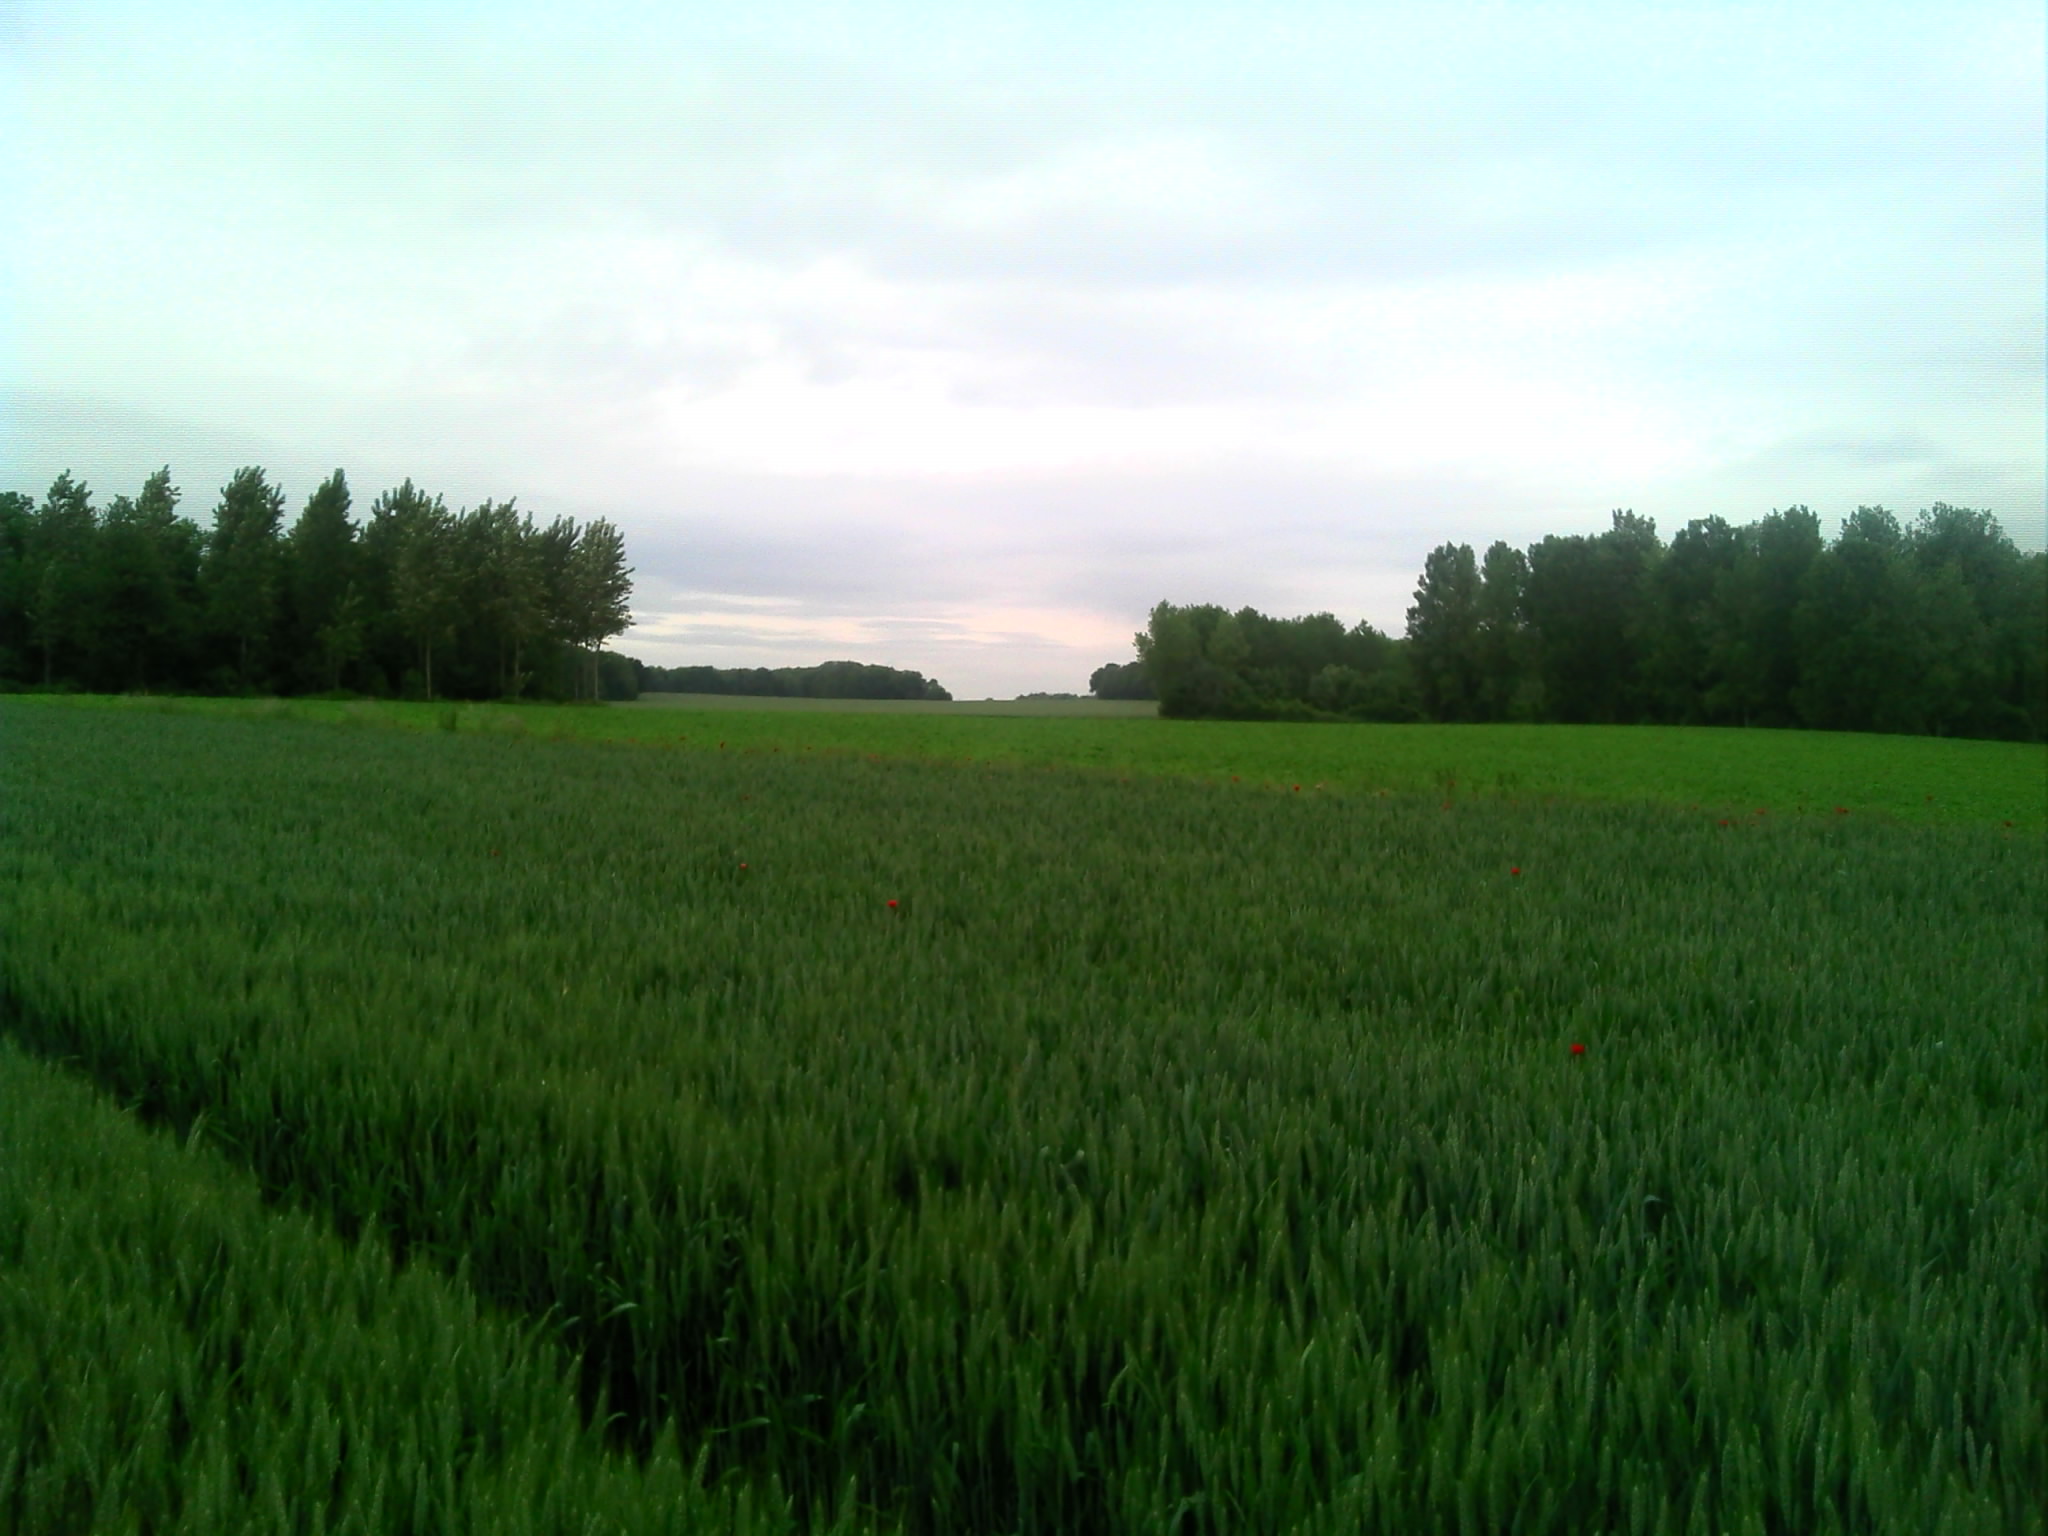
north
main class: Cropland
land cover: Common wheat
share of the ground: > 75 %
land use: Agriculture (excluding fallow land and kitchen gardens)
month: June
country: FR
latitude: 49.7144
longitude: 3.2653
